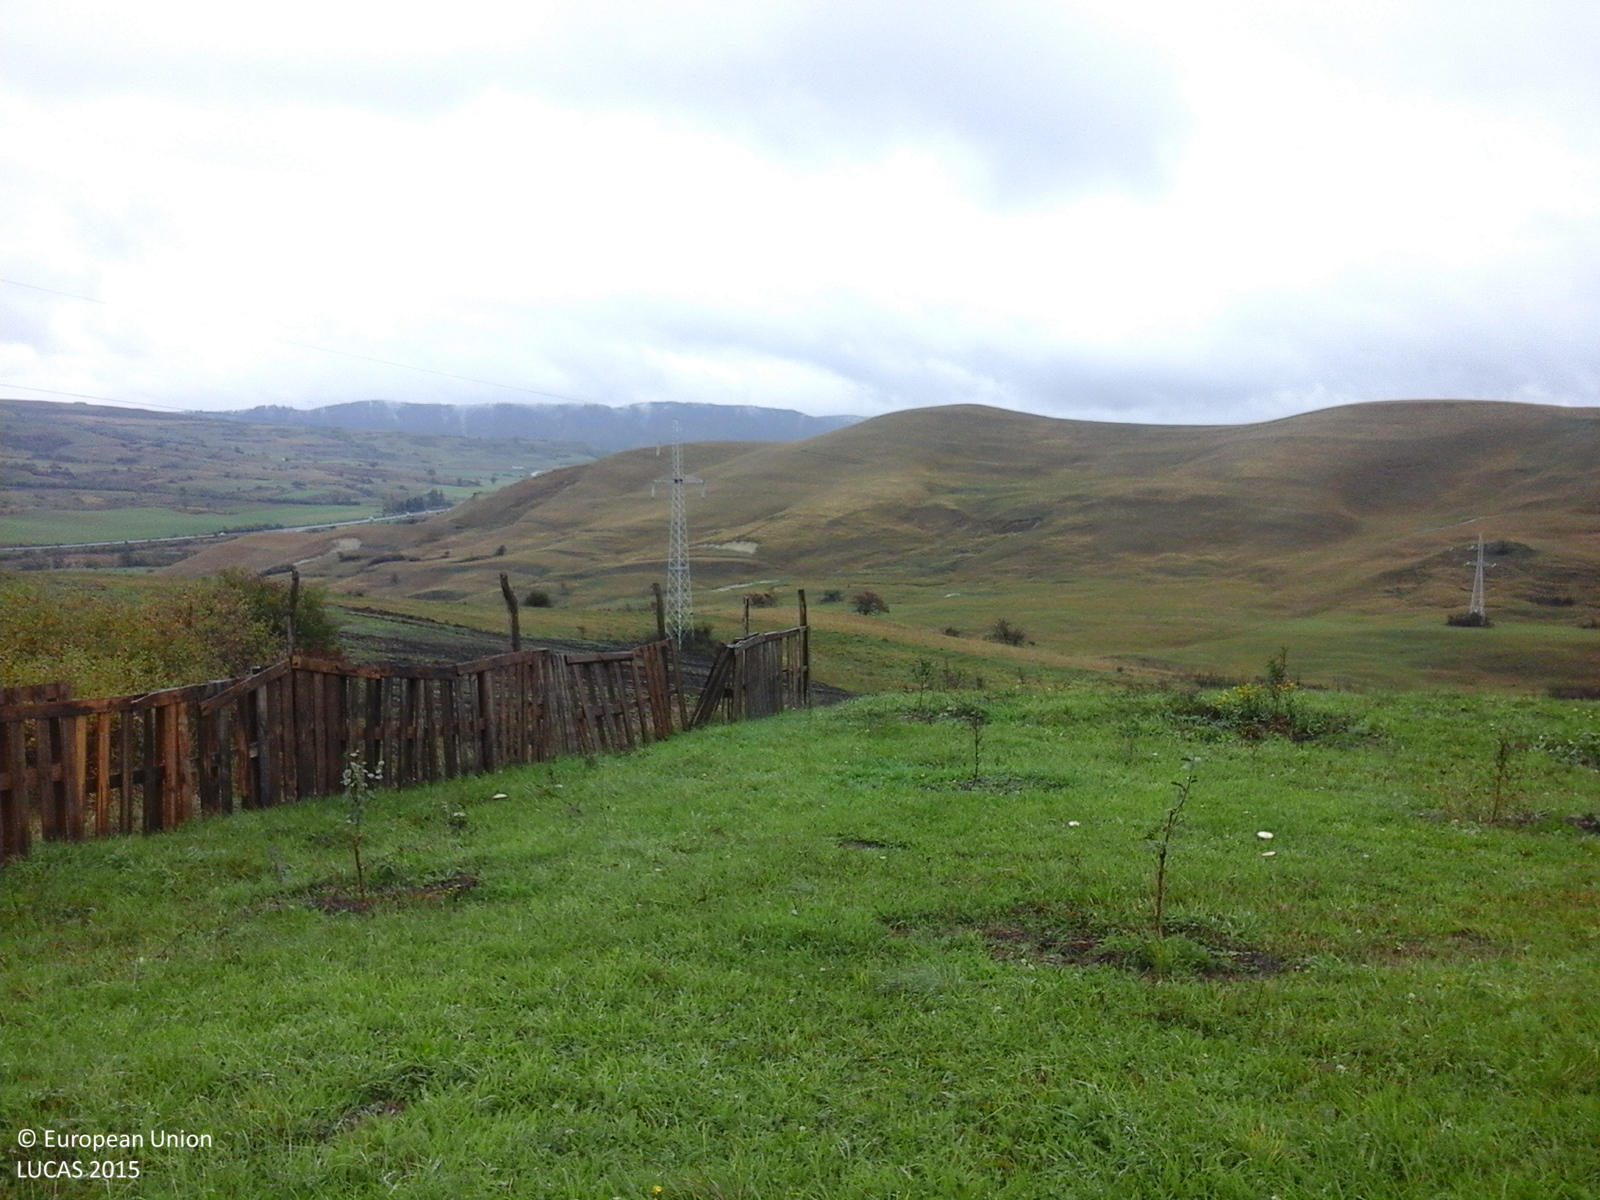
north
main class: Cropland
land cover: Apple fruit
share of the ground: 10 - 25 %
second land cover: Grassland without tree/shrub cover
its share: > 75 %
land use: Agriculture (excluding fallow land and kitchen gardens)
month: October
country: RO
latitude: 45.9881
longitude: 24.1609
